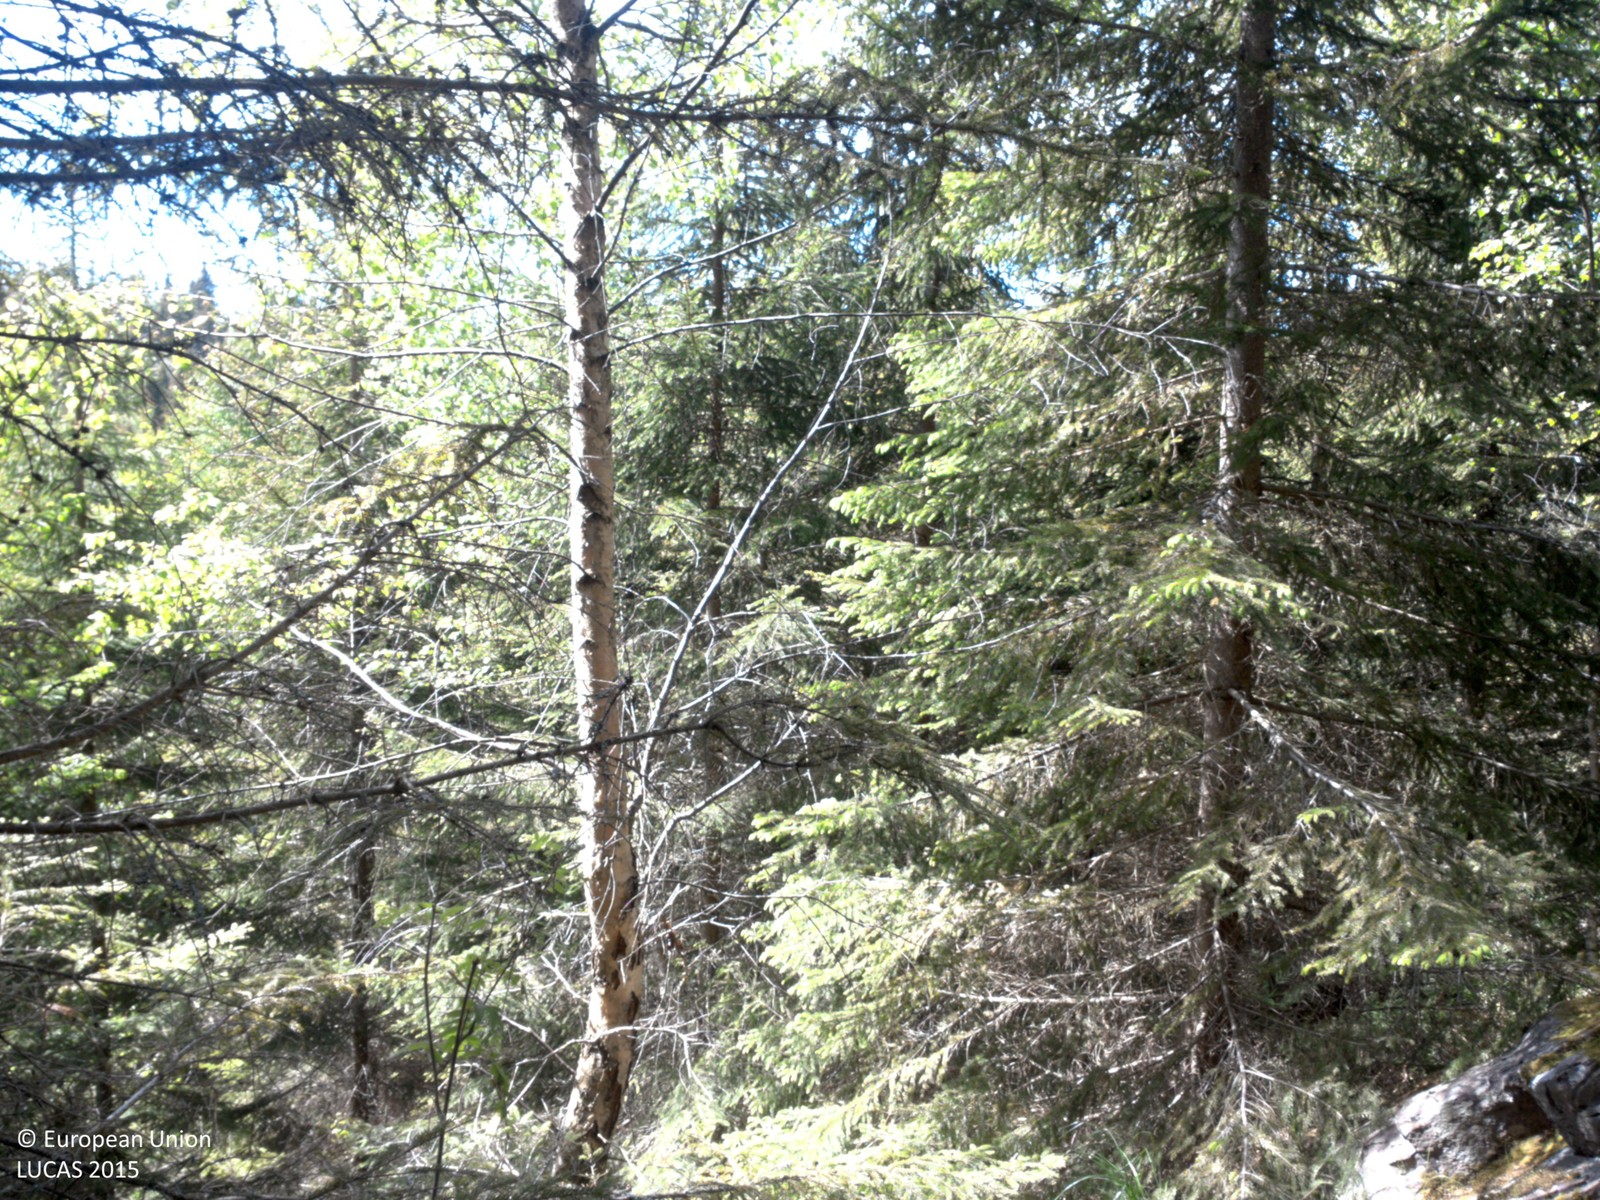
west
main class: Woodland
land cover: Spruce dominated mixed woodland
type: boreal forest
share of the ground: > 75 %
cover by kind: coniferous forest trees 55 %, broadleaved forest trees 25 %, lichens and mosses 15 %, shrubs 5 %
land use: Forestry
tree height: > 5 m
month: June
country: SE
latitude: 59.0802
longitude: 12.3848
